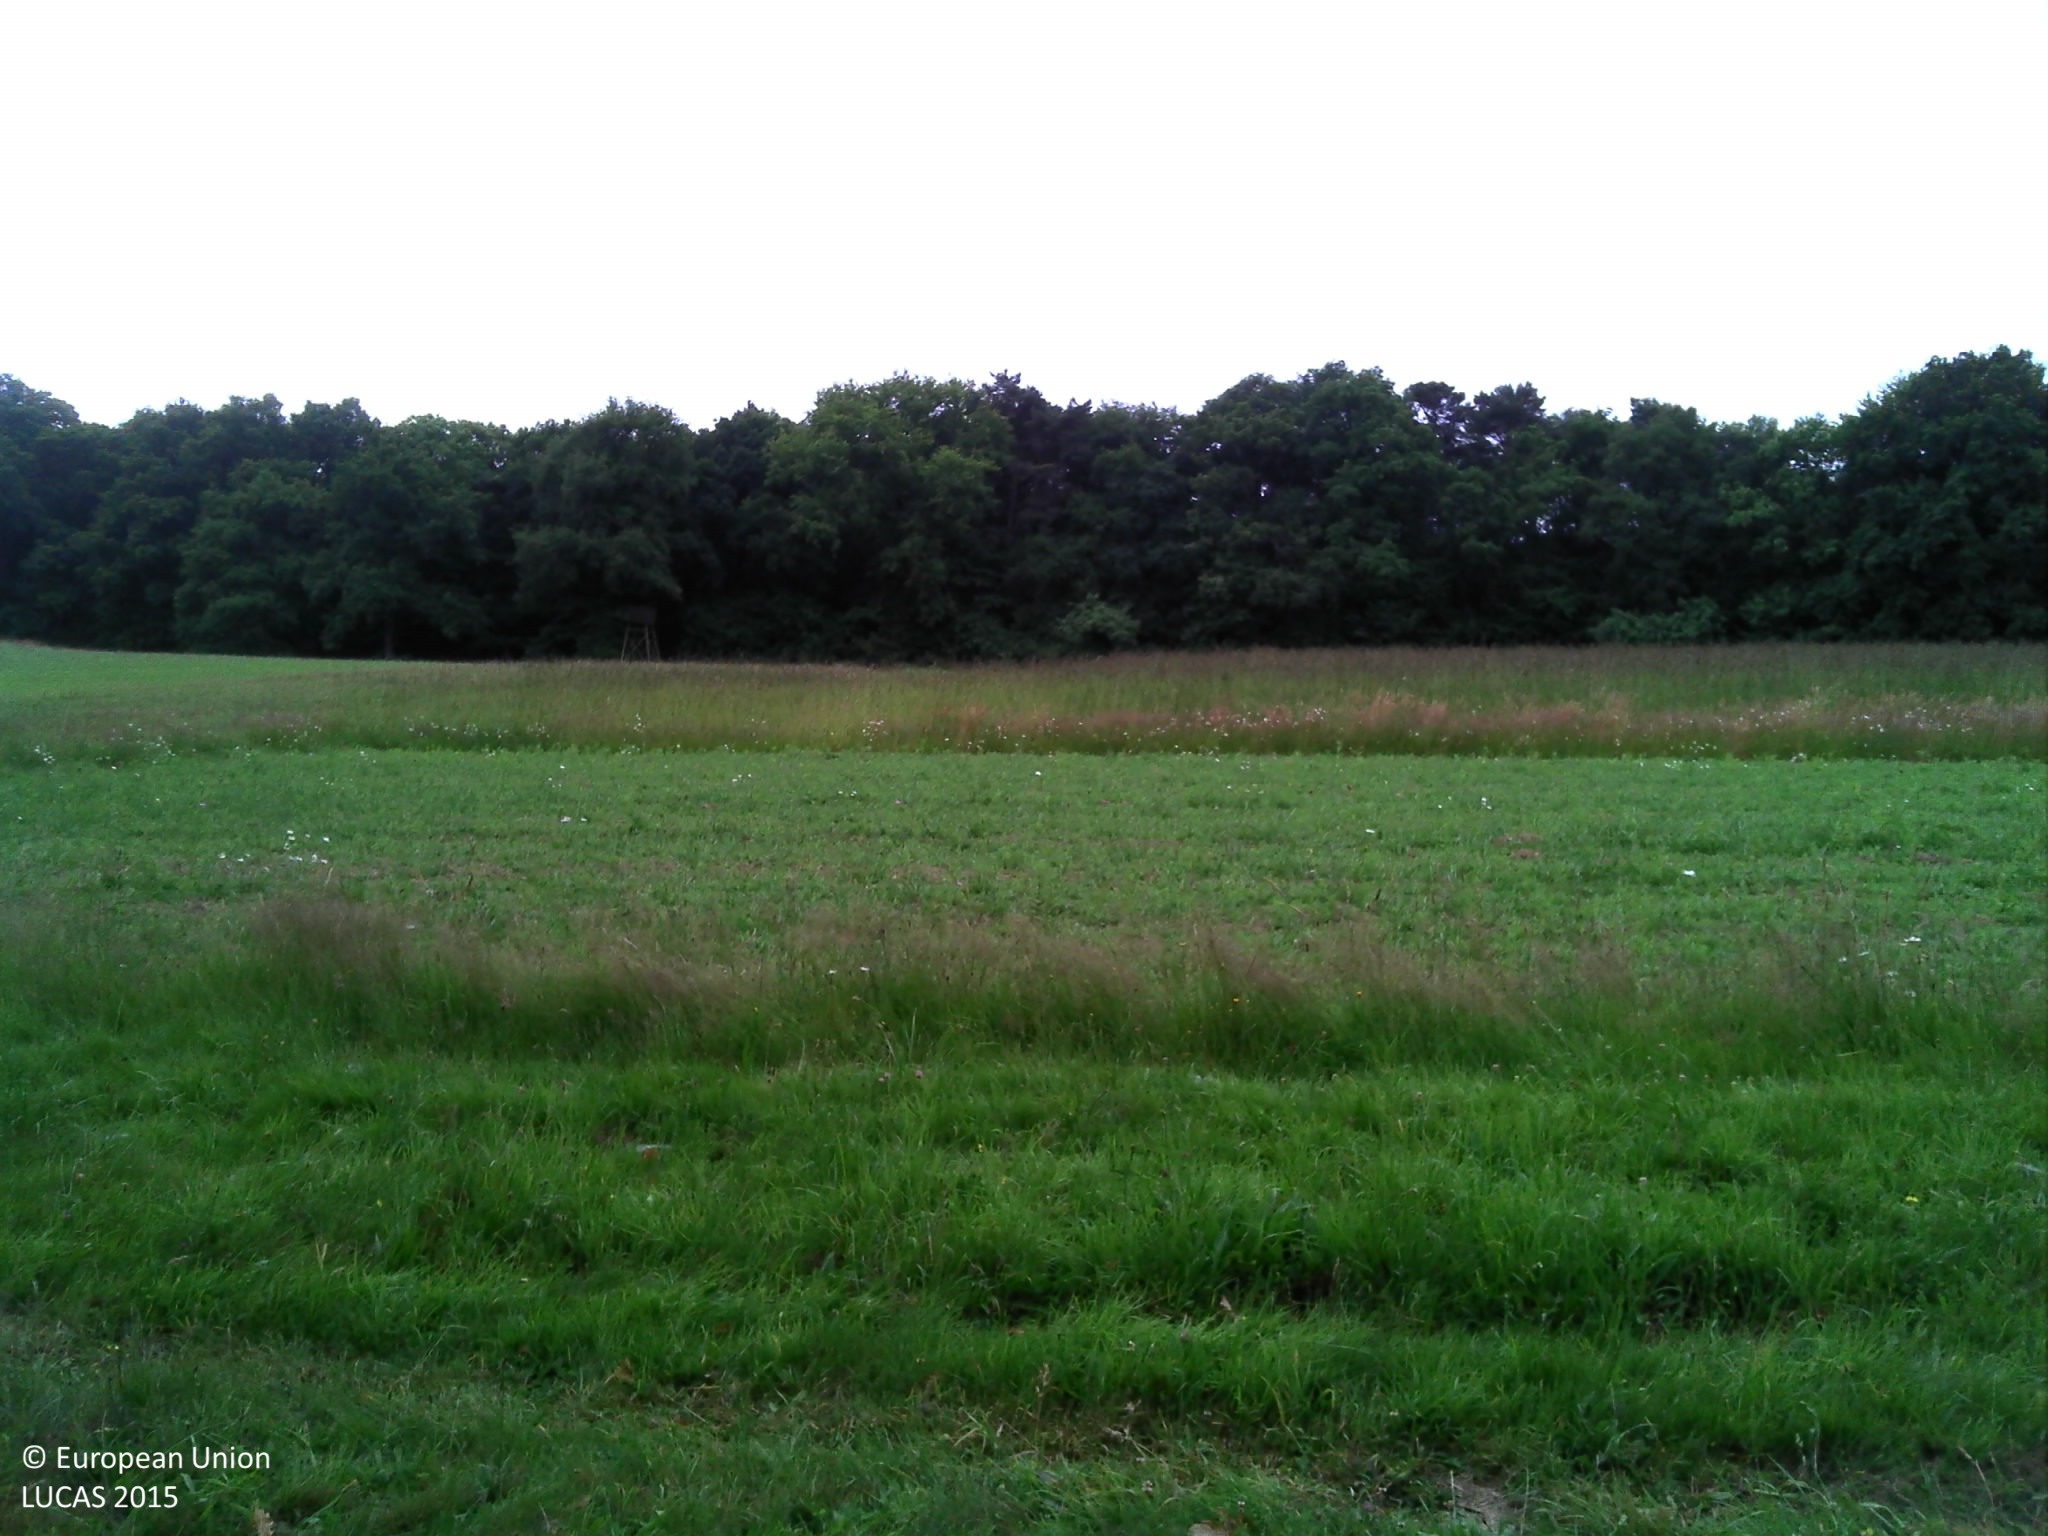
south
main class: Woodland
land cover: Broadleaved woodland
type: acidophilous oak and oak-birch forest
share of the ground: > 75 %
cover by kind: broadleaved forest trees 90 %, herbaceous plants 10 %
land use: Forestry
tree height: > 5 m
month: June
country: FR
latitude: 47.9604
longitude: -1.7126
